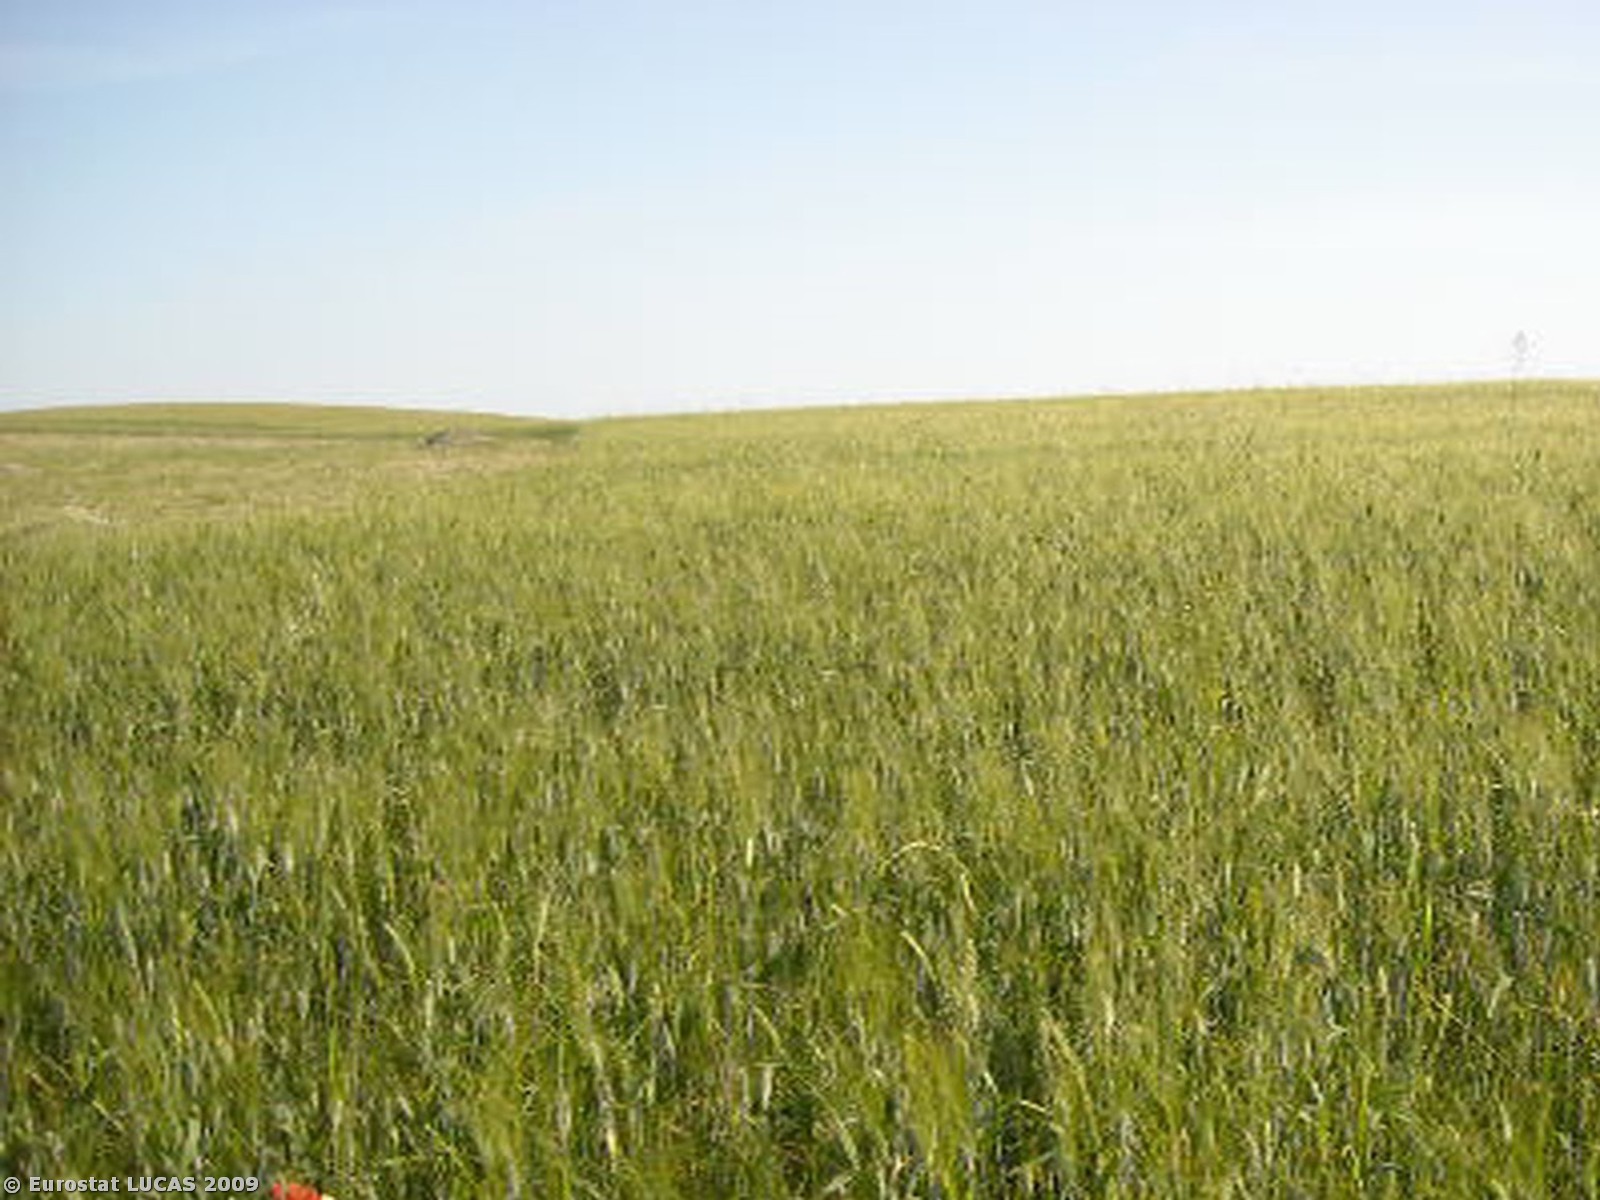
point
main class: Cropland
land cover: Durum wheat
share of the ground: > 75 %
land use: Agriculture (excluding fallow land and kitchen gardens)
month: May
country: IT
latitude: 40.6988
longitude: 16.5927
